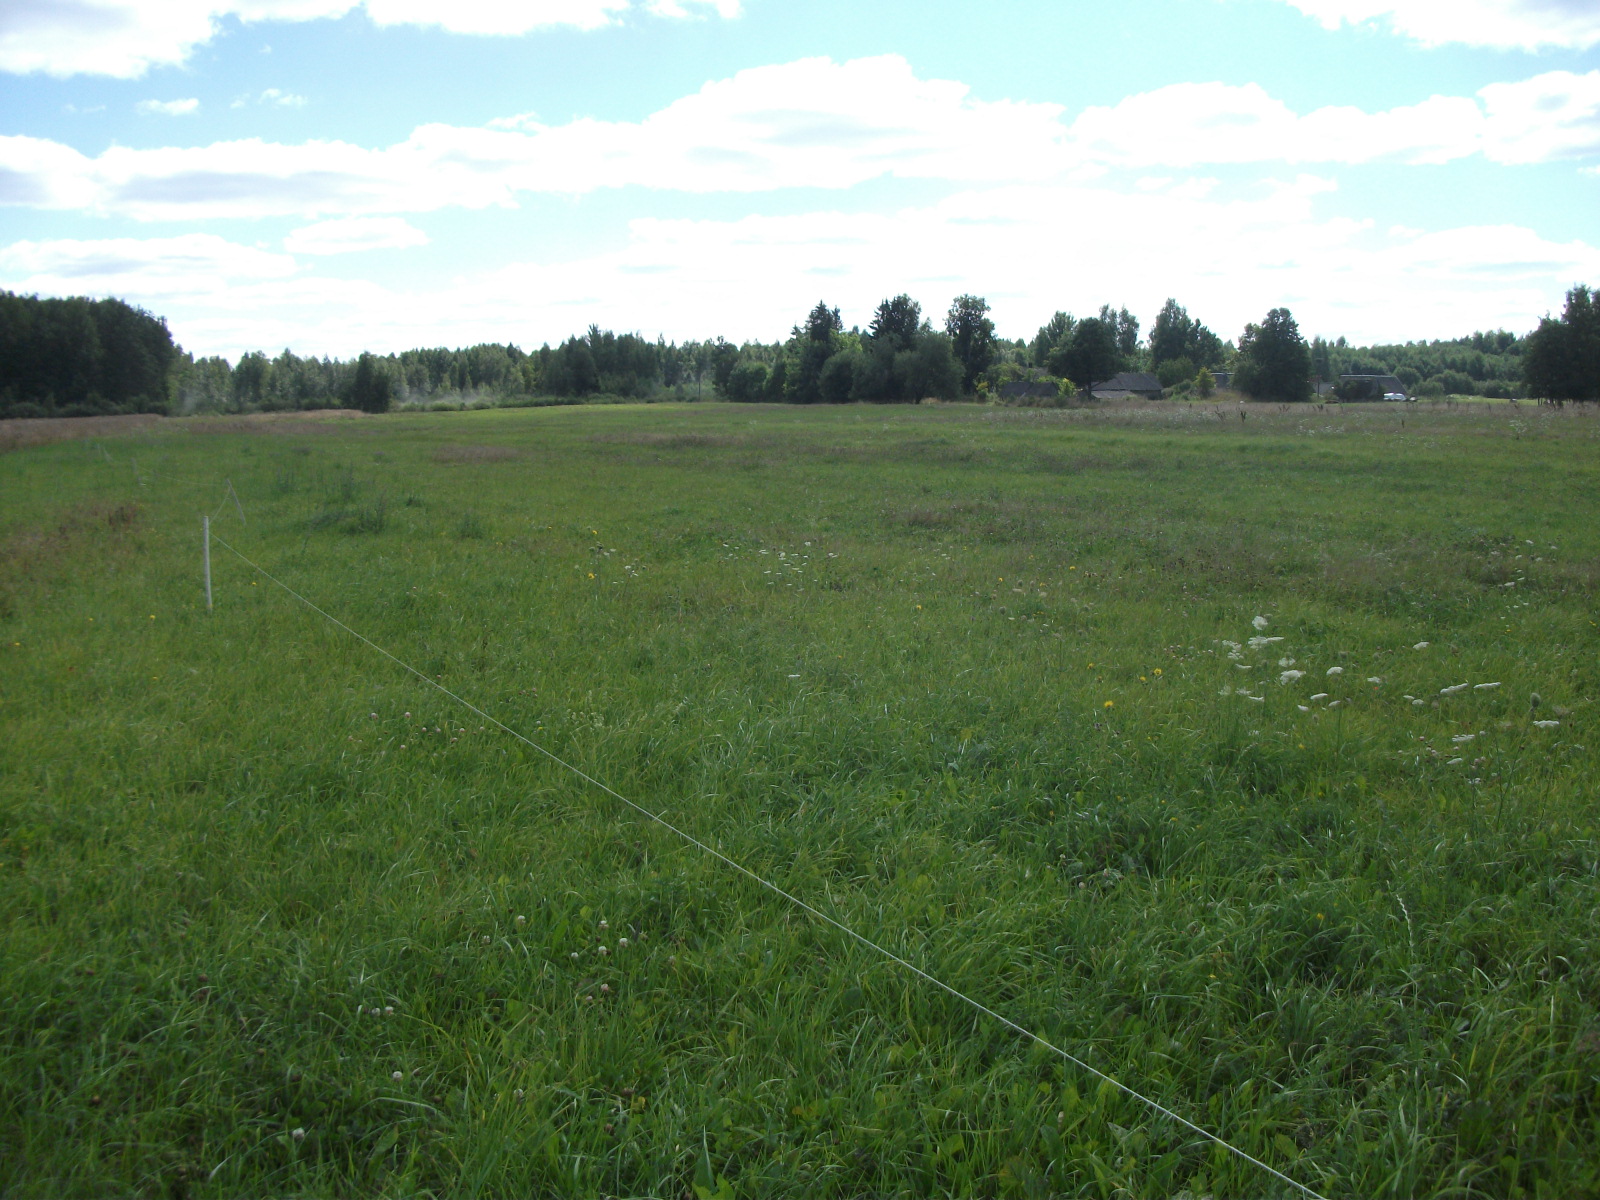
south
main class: Grassland
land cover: Grassland without tree/shrub cover
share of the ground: > 75 %
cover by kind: herbaceous plants 100 %
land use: Agriculture (excluding fallow land and kitchen gardens)
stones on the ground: < 10 %
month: August
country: LV
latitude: 56.5530
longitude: 26.4298
